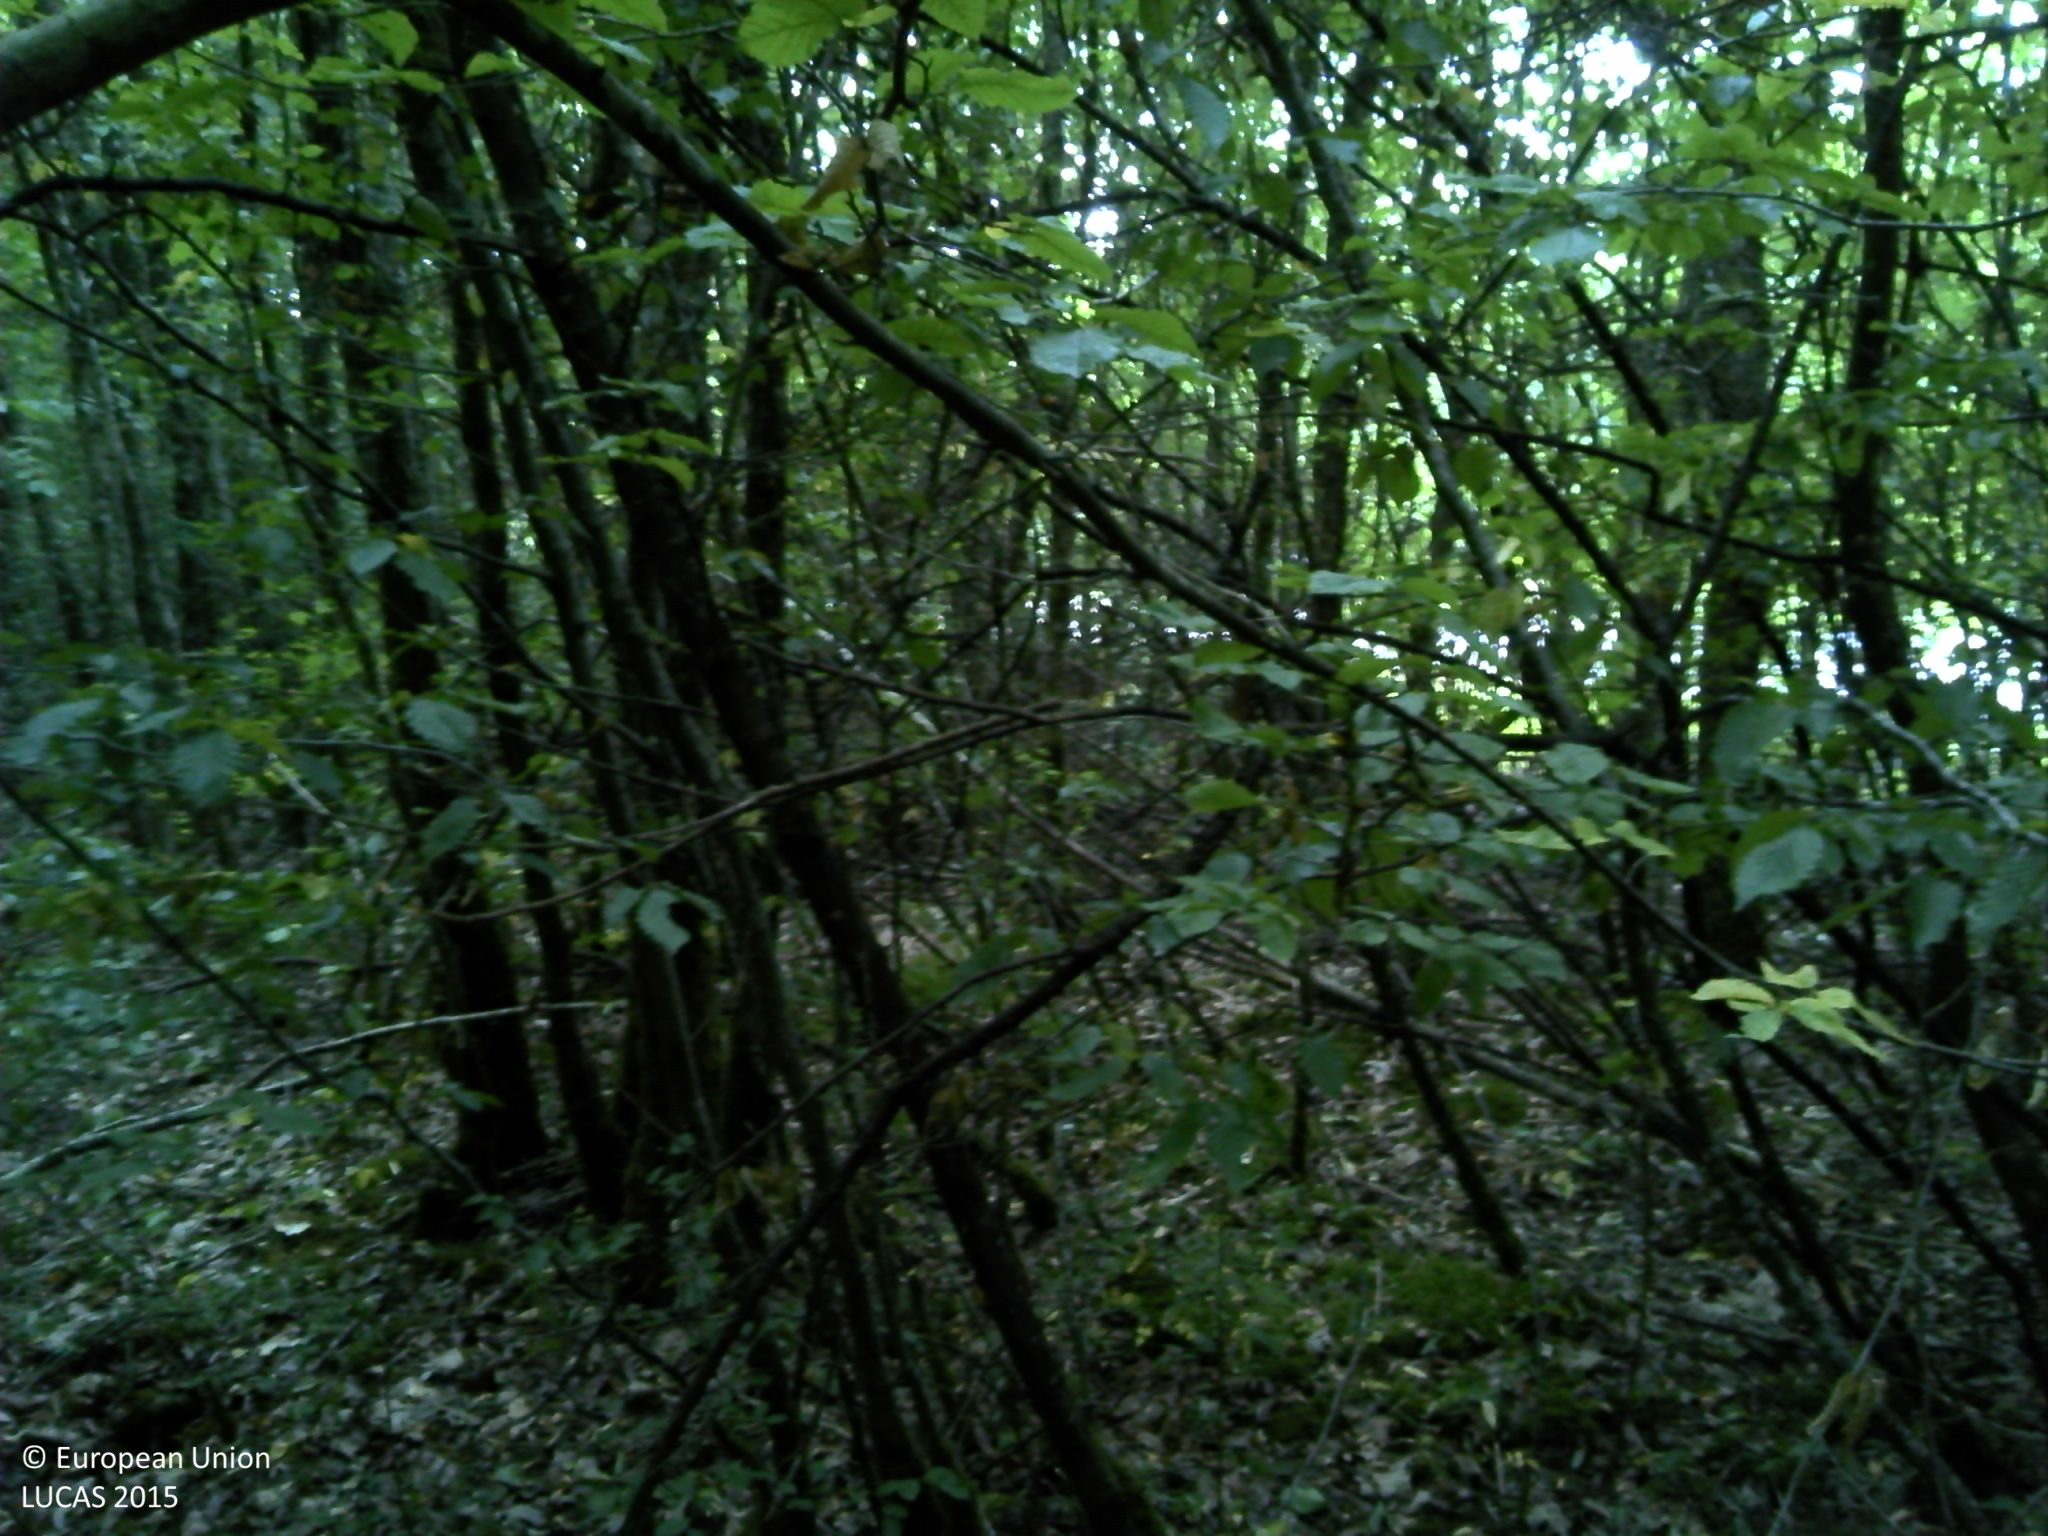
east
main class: Woodland
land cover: Broadleaved woodland
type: beech forest
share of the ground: > 75 %
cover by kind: broadleaved forest trees 100 %
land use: Forestry
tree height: > 5 m
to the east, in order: Broadleaved woodland; Ditches and canals; Grass margins; Paved roads, cycling and walking lanes; Grass margins; Ditches and canals; Broadleaved woodland
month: July
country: FR
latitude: 48.1022
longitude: 6.1464
